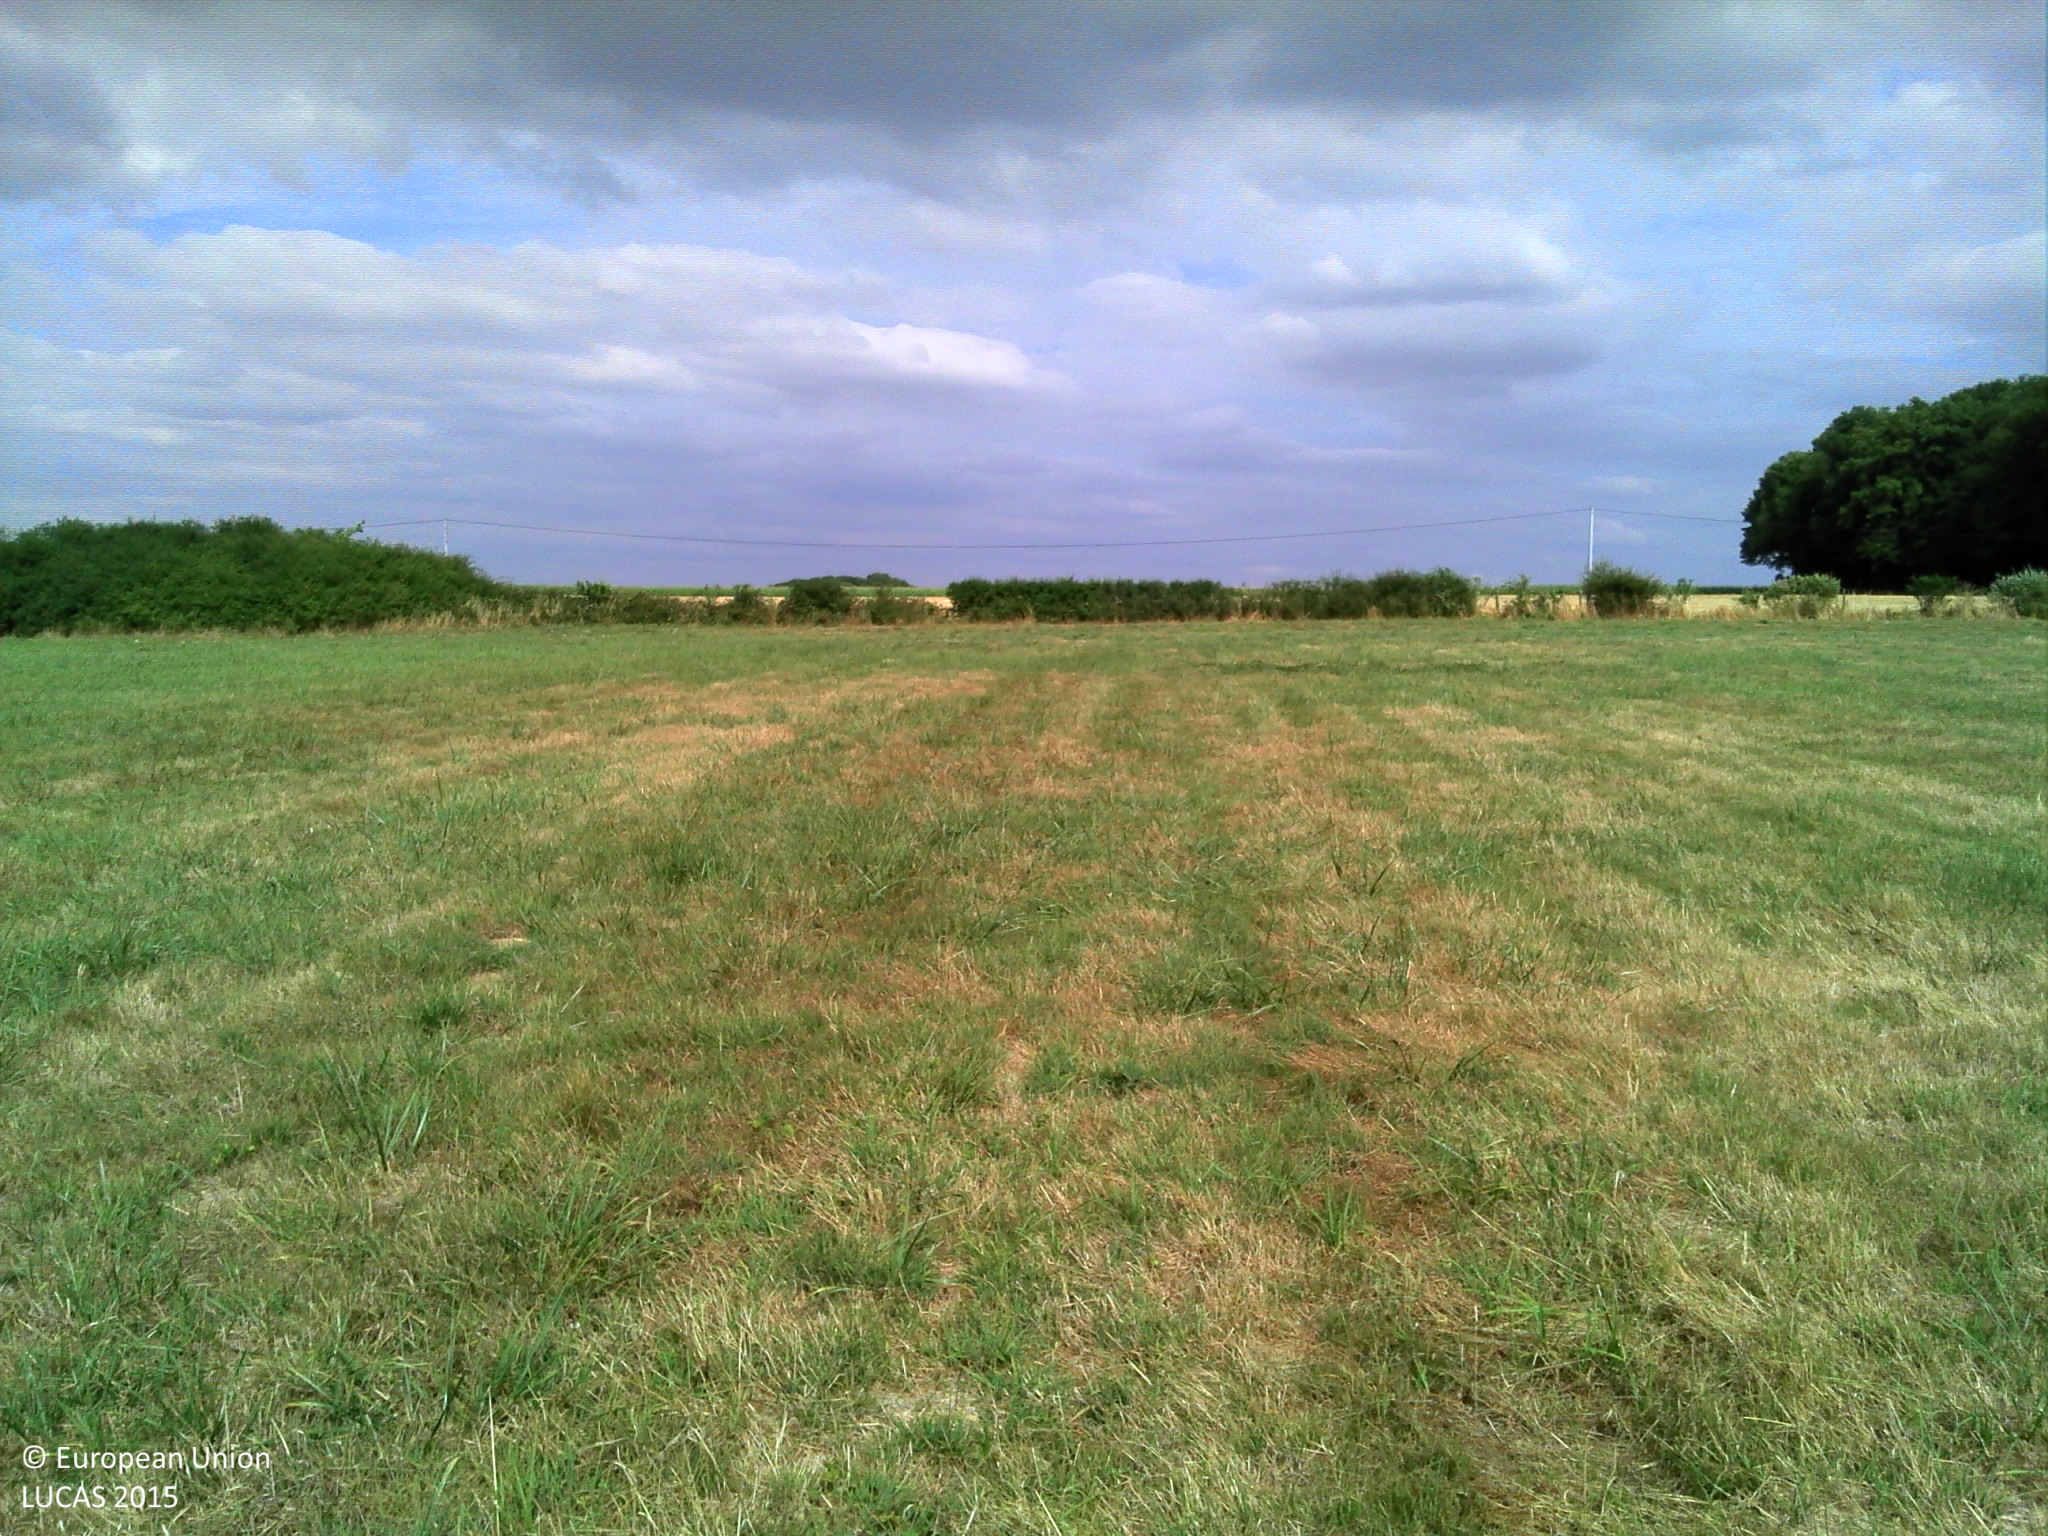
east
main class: Grassland
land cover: Grassland without tree/shrub cover
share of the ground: > 75 %
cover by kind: herbaceous plants 100 %
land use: Agriculture (excluding fallow land and kitchen gardens)
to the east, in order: Grassland without tree/shrub cover; Fences; Managed hedges; Electric lines; Grass margins; Ditches and canals; Grass margins; Paved roads, cycling and walking lanes; Grass margins; Ditches and canals; Grass margins; Common wheat
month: July
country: FR
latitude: 48.1124
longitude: 3.0487
